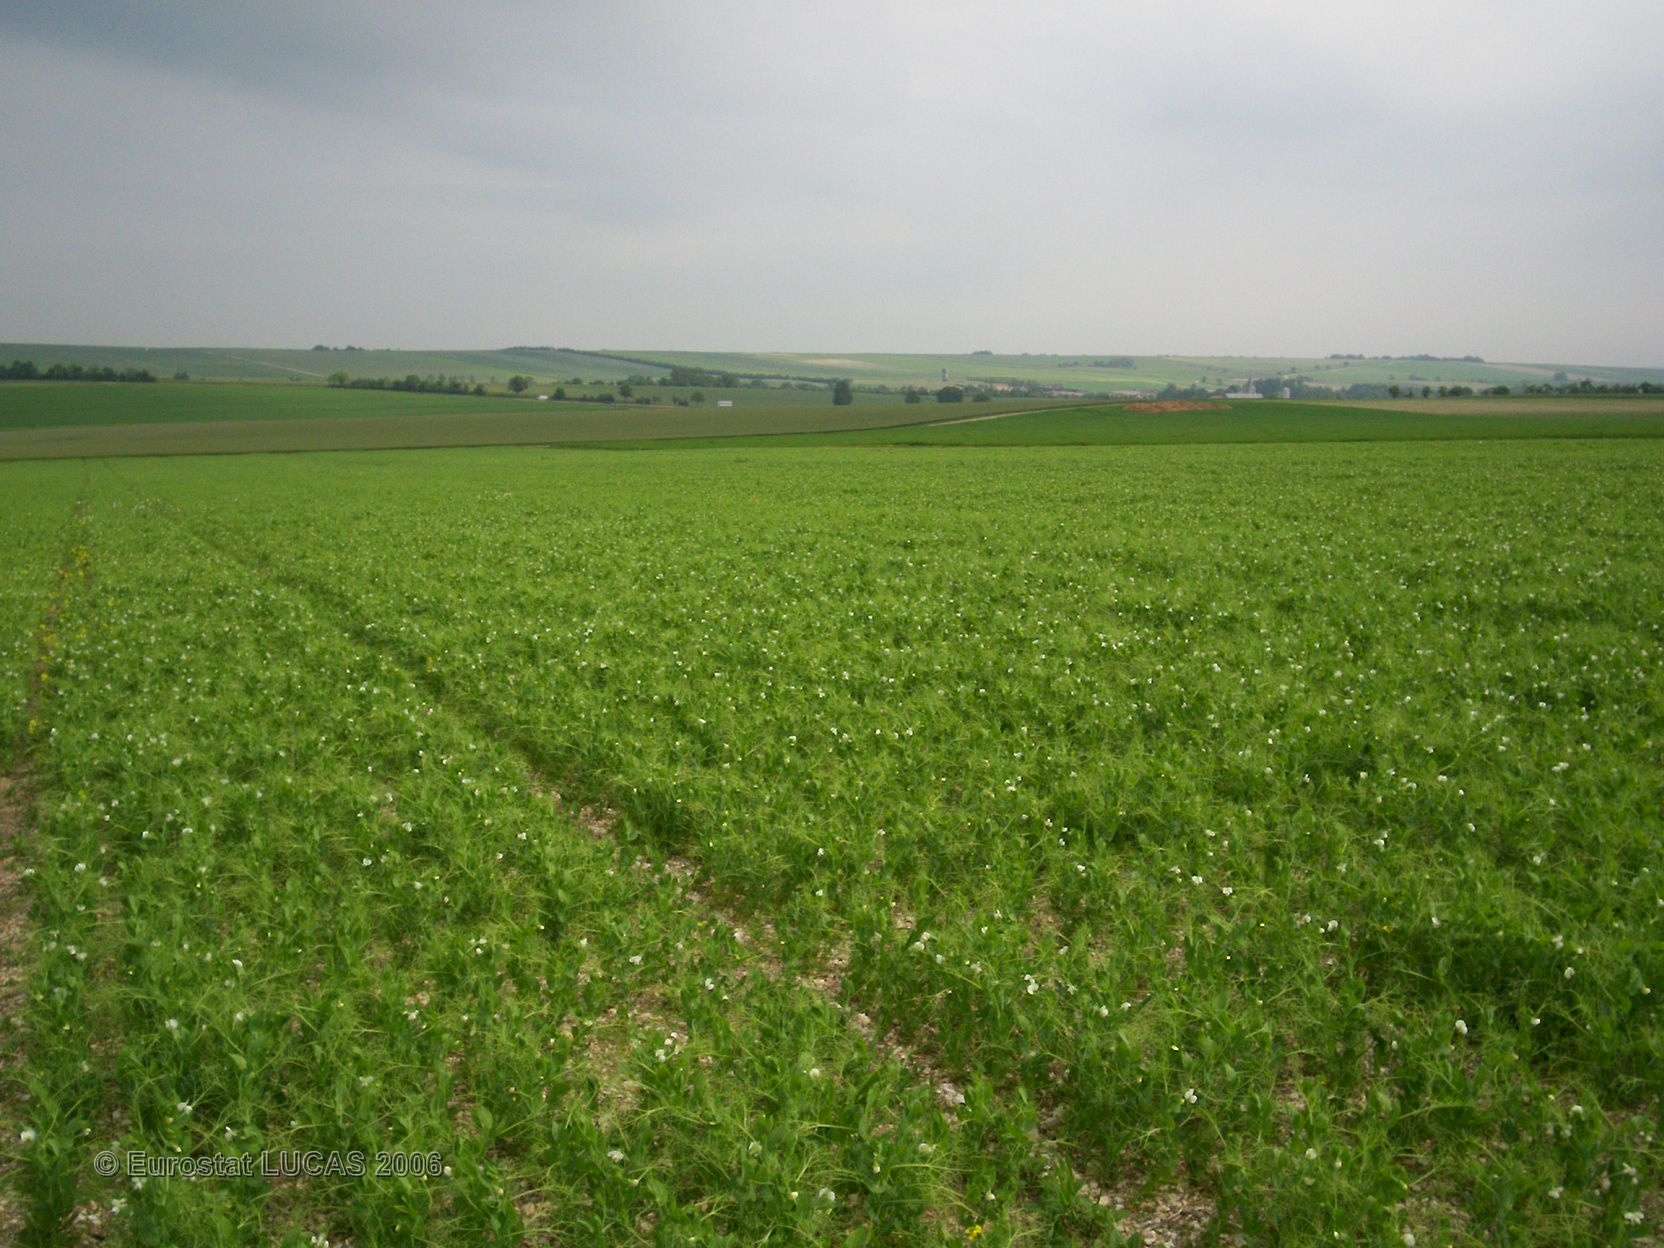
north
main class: Cropland
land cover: Dry pulses
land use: Agriculture (excluding fallow land and kitchen gardens)
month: June
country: FR
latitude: 48.7350
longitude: 4.4902
